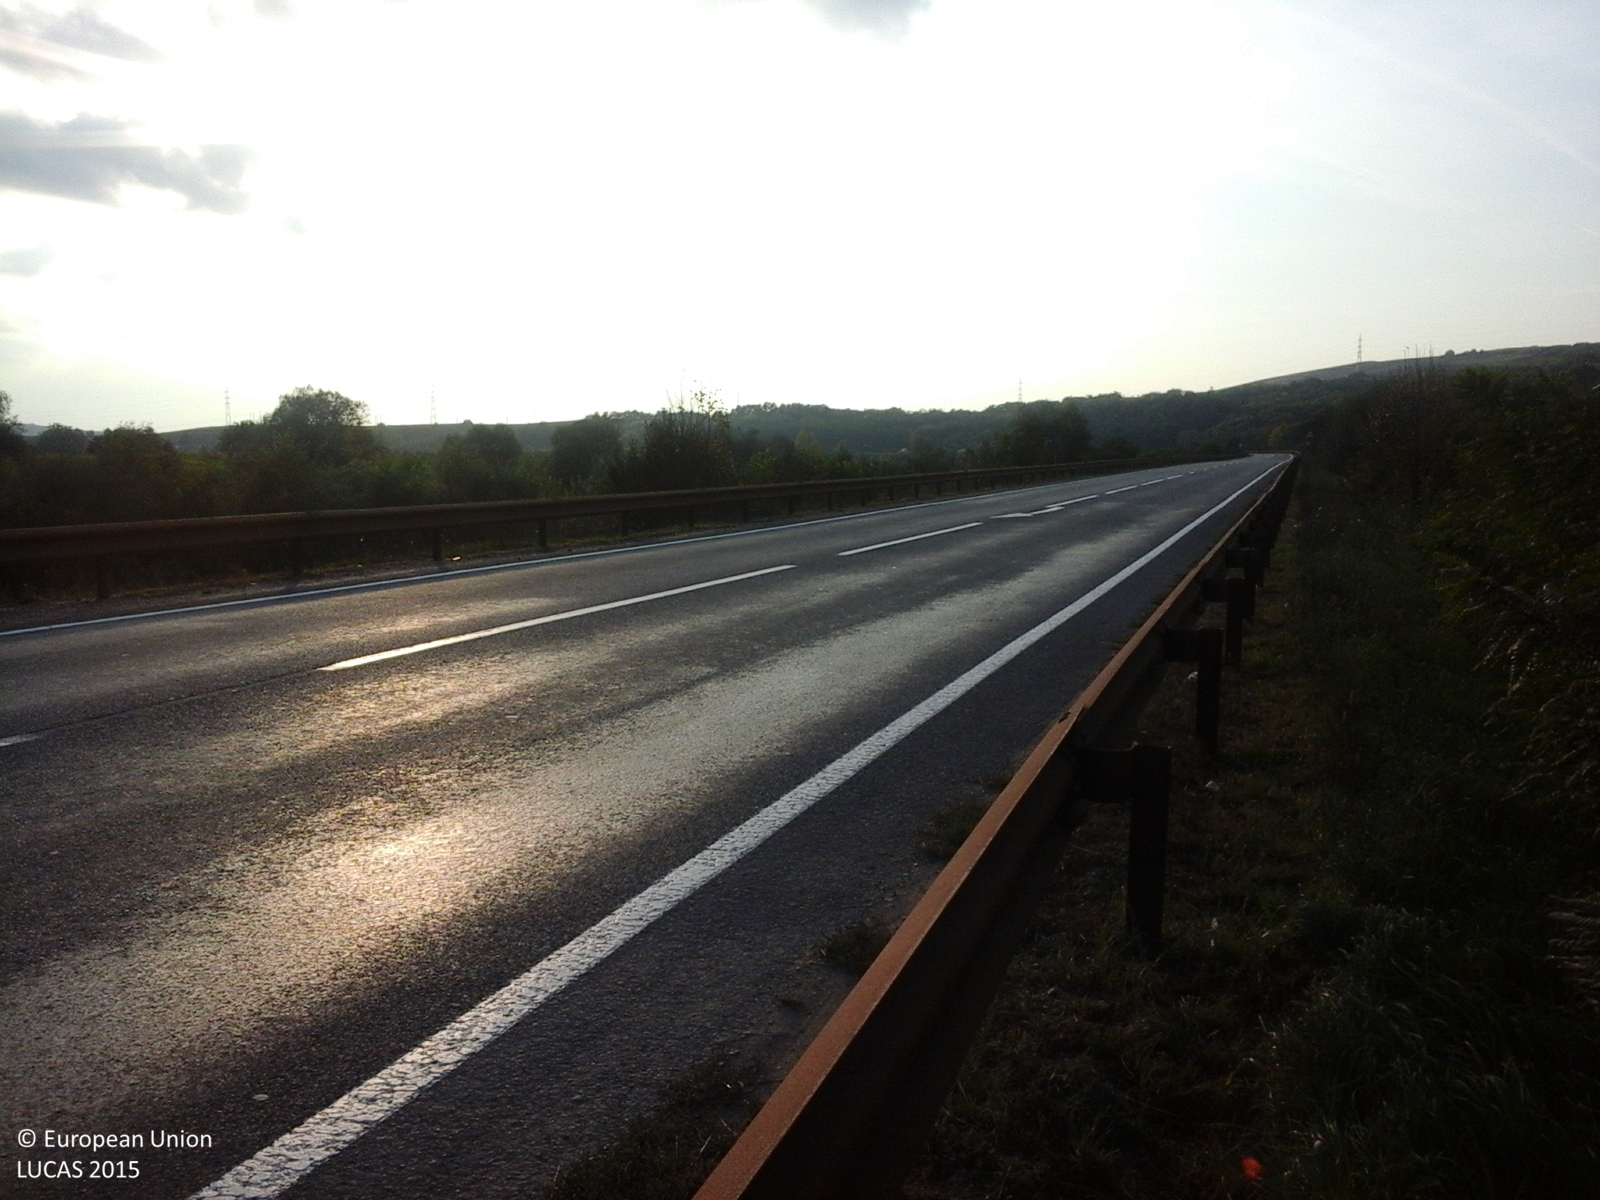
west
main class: Shrubland
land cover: Shrubland with sparse tree cover
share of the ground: > 75 %
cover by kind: shrubs 95 %, broadleaved forest trees 5 %
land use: Road transport
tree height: < 5 m
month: October
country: RO
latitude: 46.4740
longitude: 24.0791
